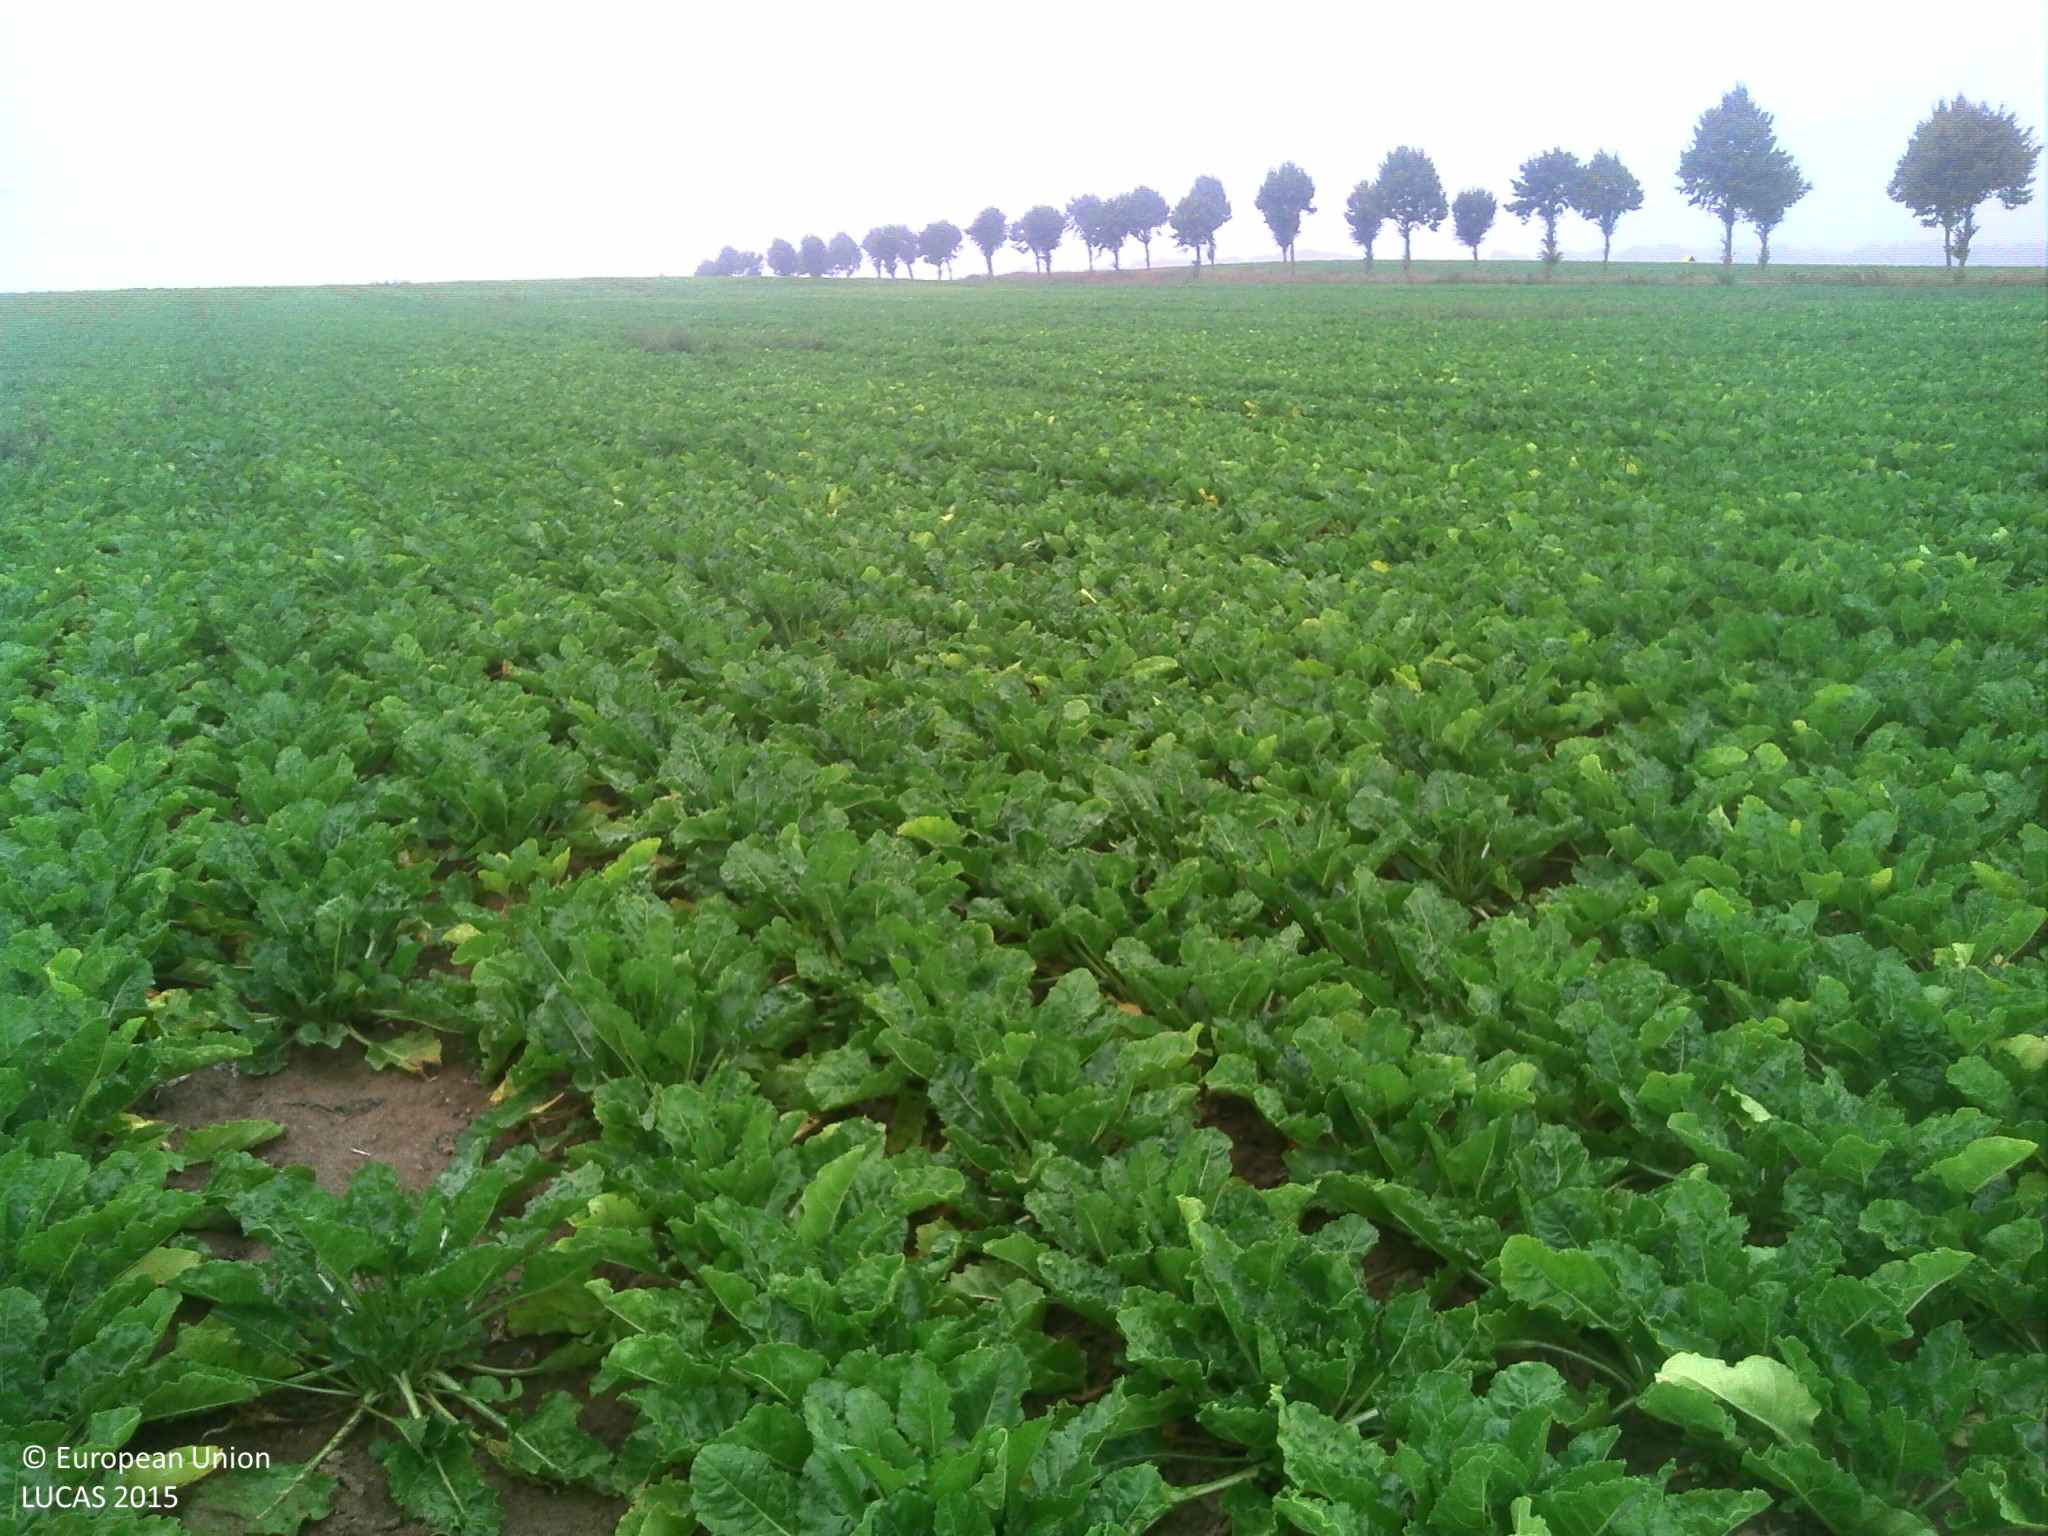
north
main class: Cropland
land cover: Sugar beet
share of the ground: > 75 %
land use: Agriculture (excluding fallow land and kitchen gardens)
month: July
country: FR
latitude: 49.9158
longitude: 3.6285
